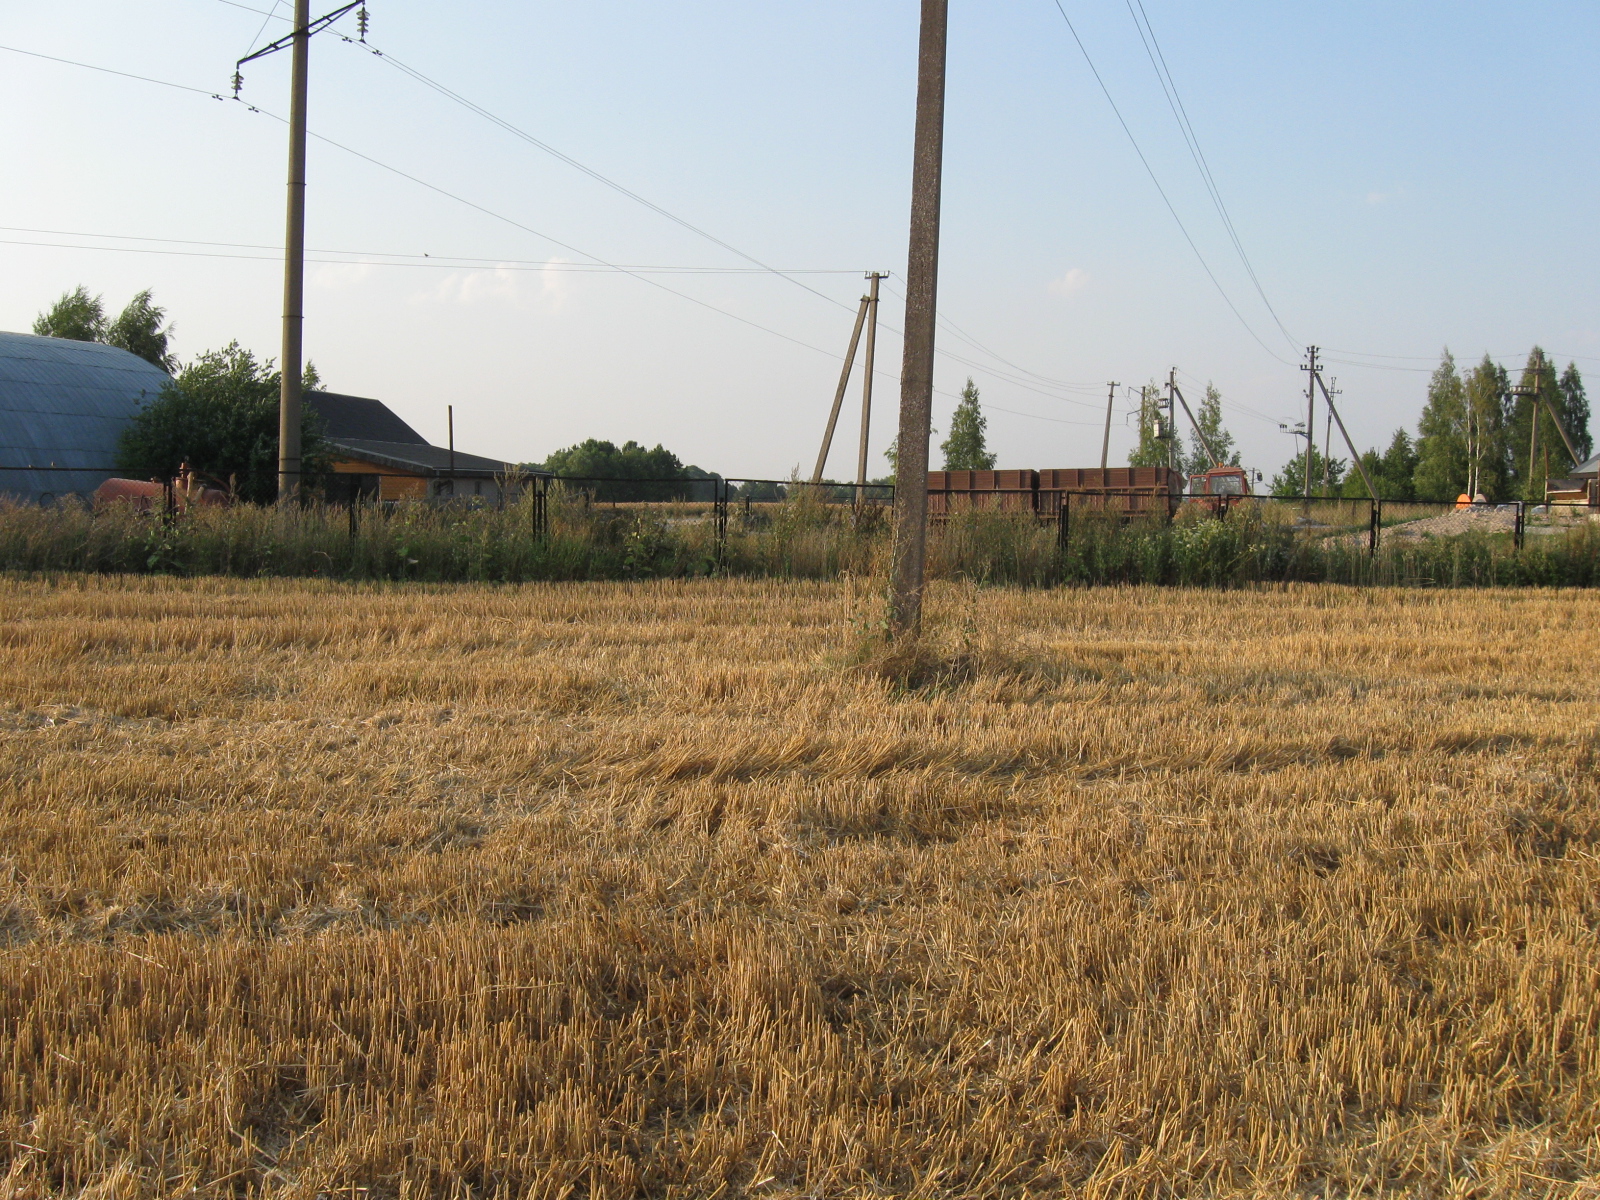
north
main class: Cropland
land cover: Common wheat
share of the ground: < 10 %
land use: Agriculture (excluding fallow land and kitchen gardens)
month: August
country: LT
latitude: 54.4727
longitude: 23.2711
